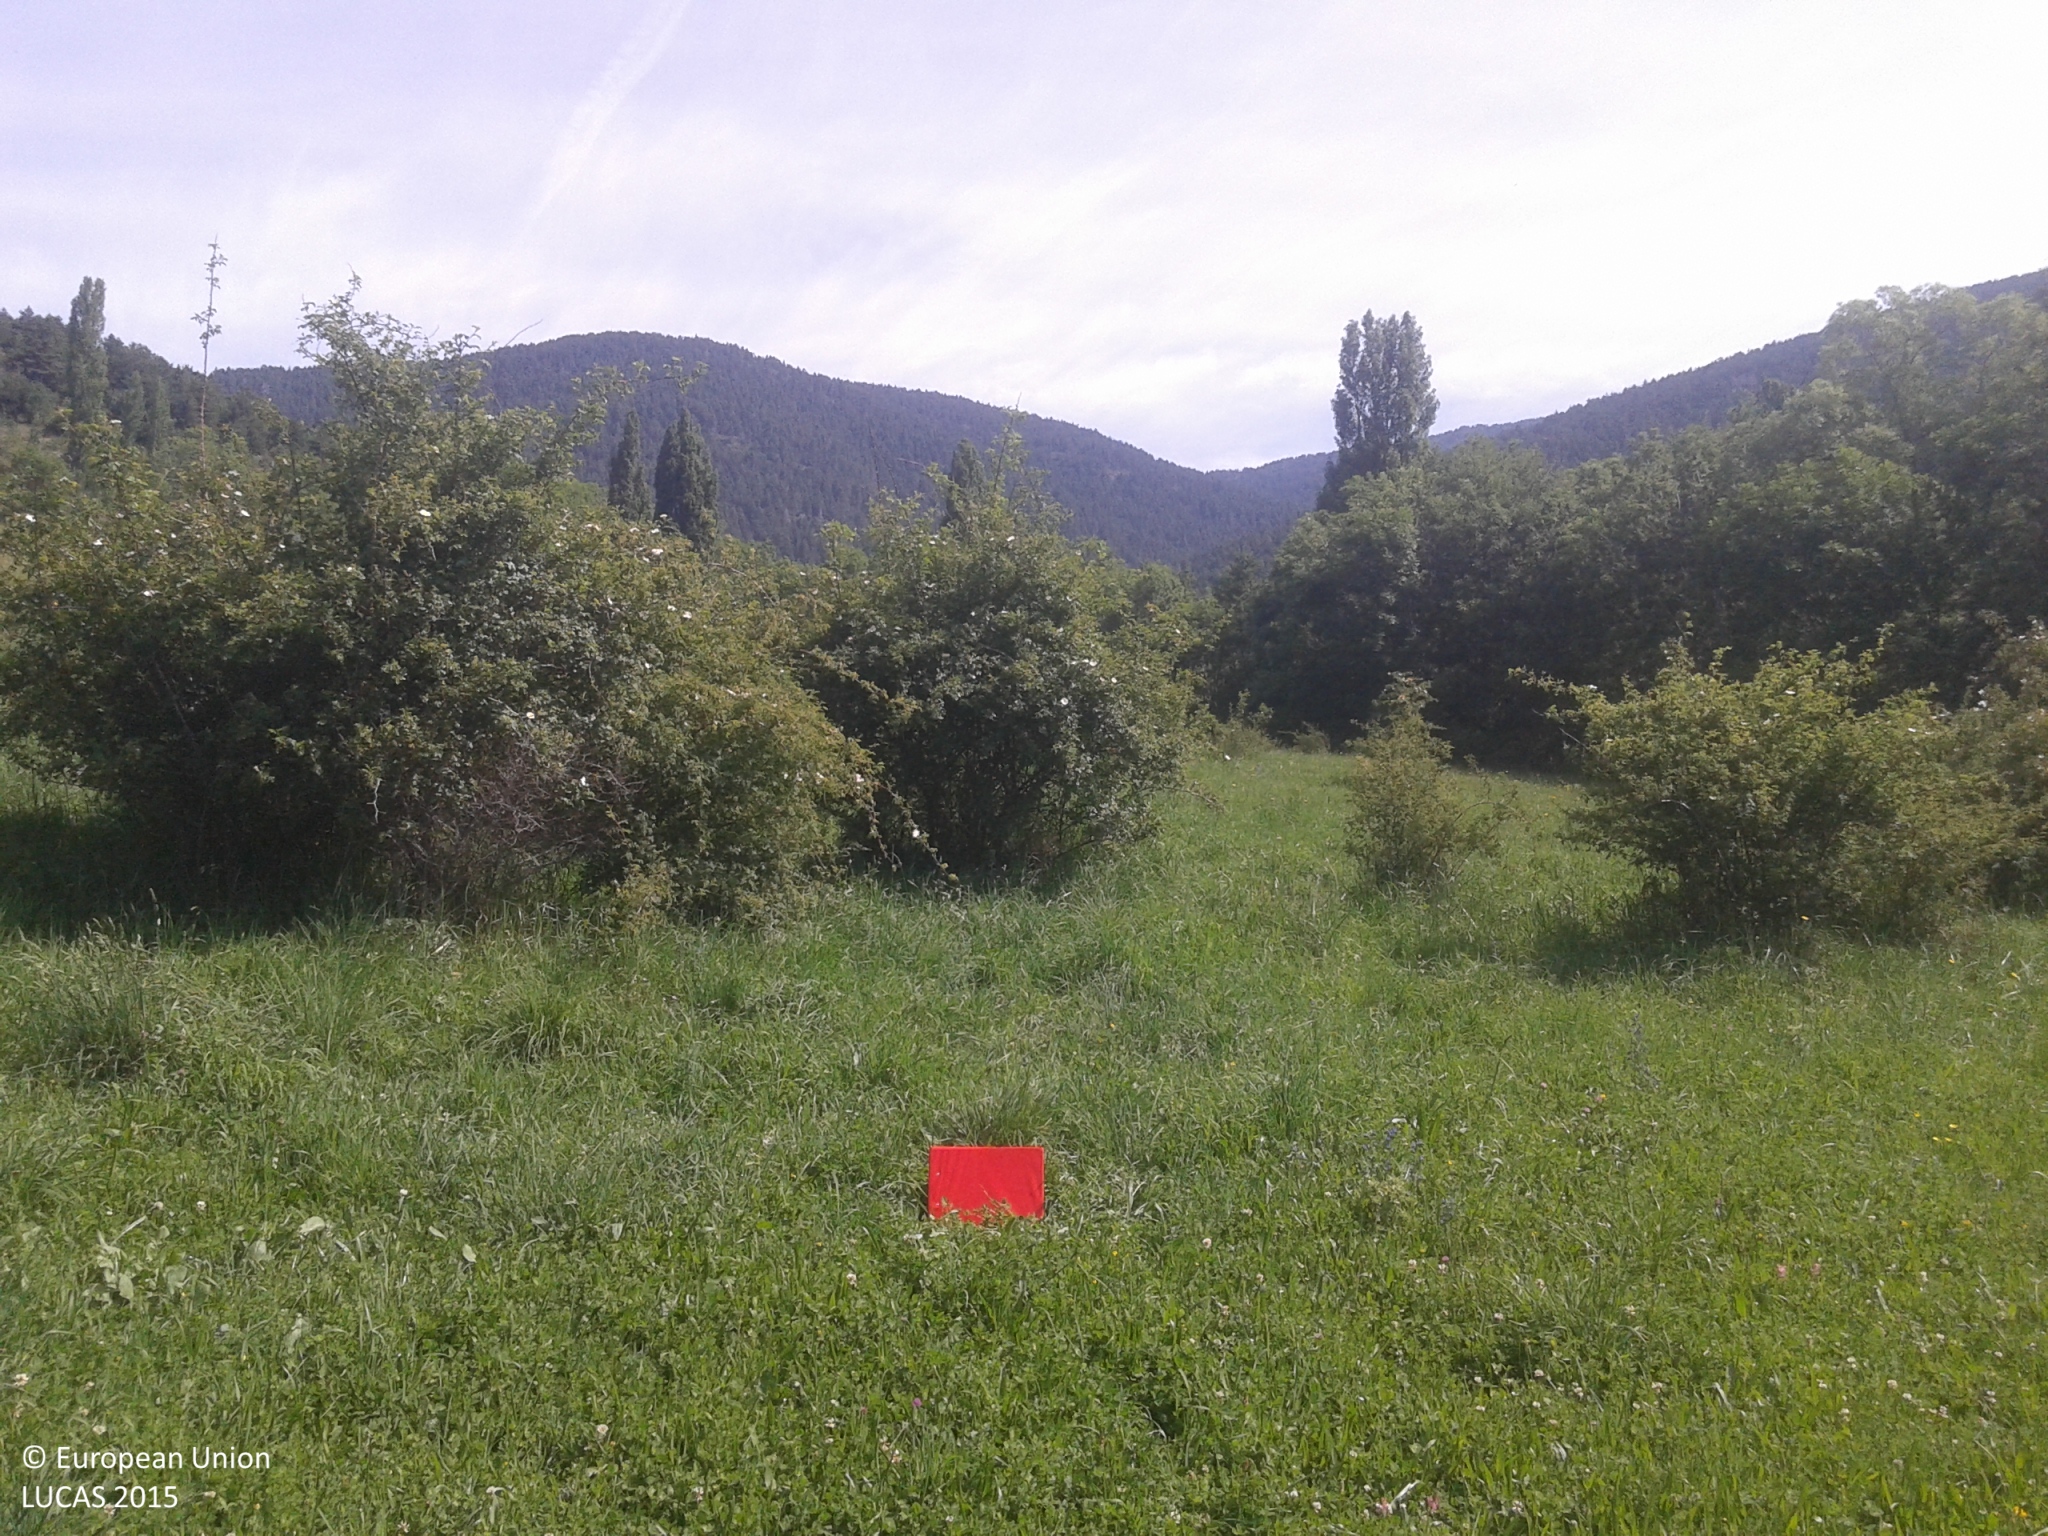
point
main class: Grassland
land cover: Grassland with sparse tree/shrub cover
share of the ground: > 75 %
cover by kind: herbaceous plants 90 %, broadleaved forest trees 5 %, shrubs 5 %
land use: Agriculture (excluding fallow land and kitchen gardens)
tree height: < 5 m
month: June
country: ES
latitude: 42.3926
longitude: 1.5675
